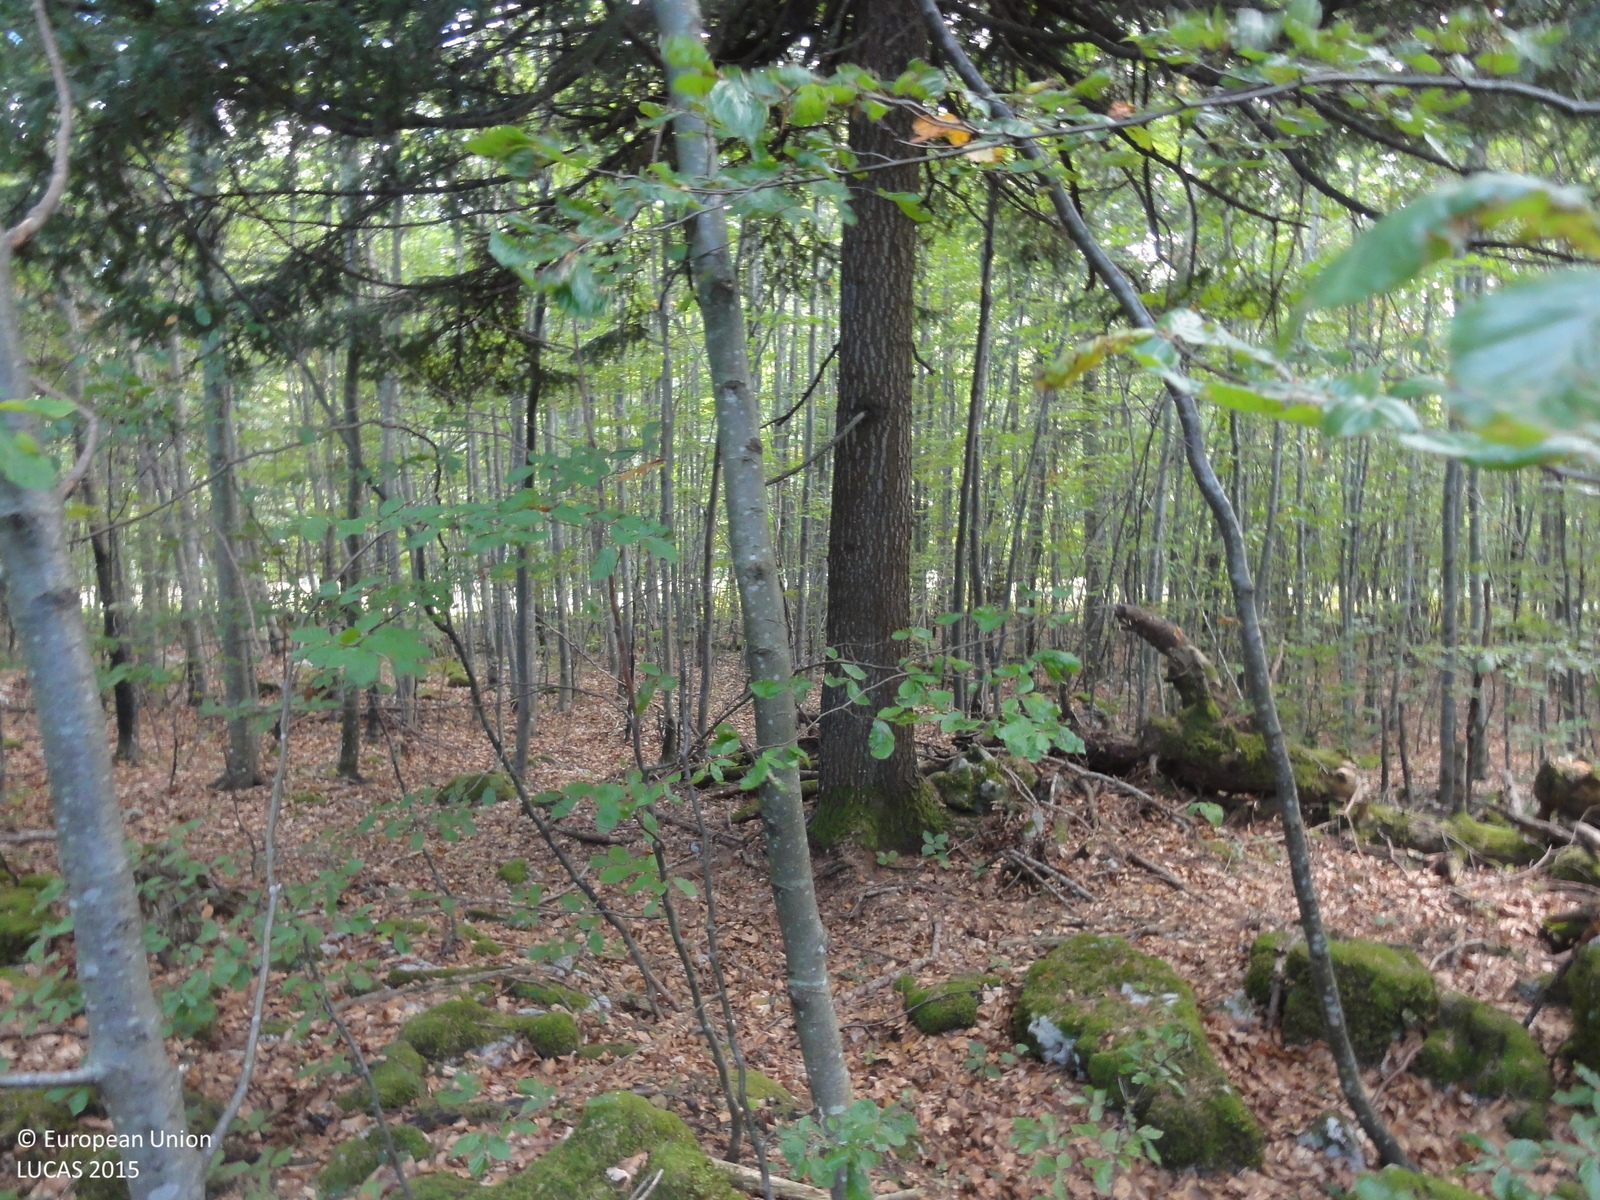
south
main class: Woodland
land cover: Spruce dominated mixed woodland
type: mountainous beech forest
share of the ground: > 75 %
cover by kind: broadleaved forest trees 55 %, coniferous forest trees 30 %, herbaceous plants 10 %, consolidated bare surface 5 %
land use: Forestry
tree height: > 5 m
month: September
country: SI
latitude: 45.6753
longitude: 14.9899
